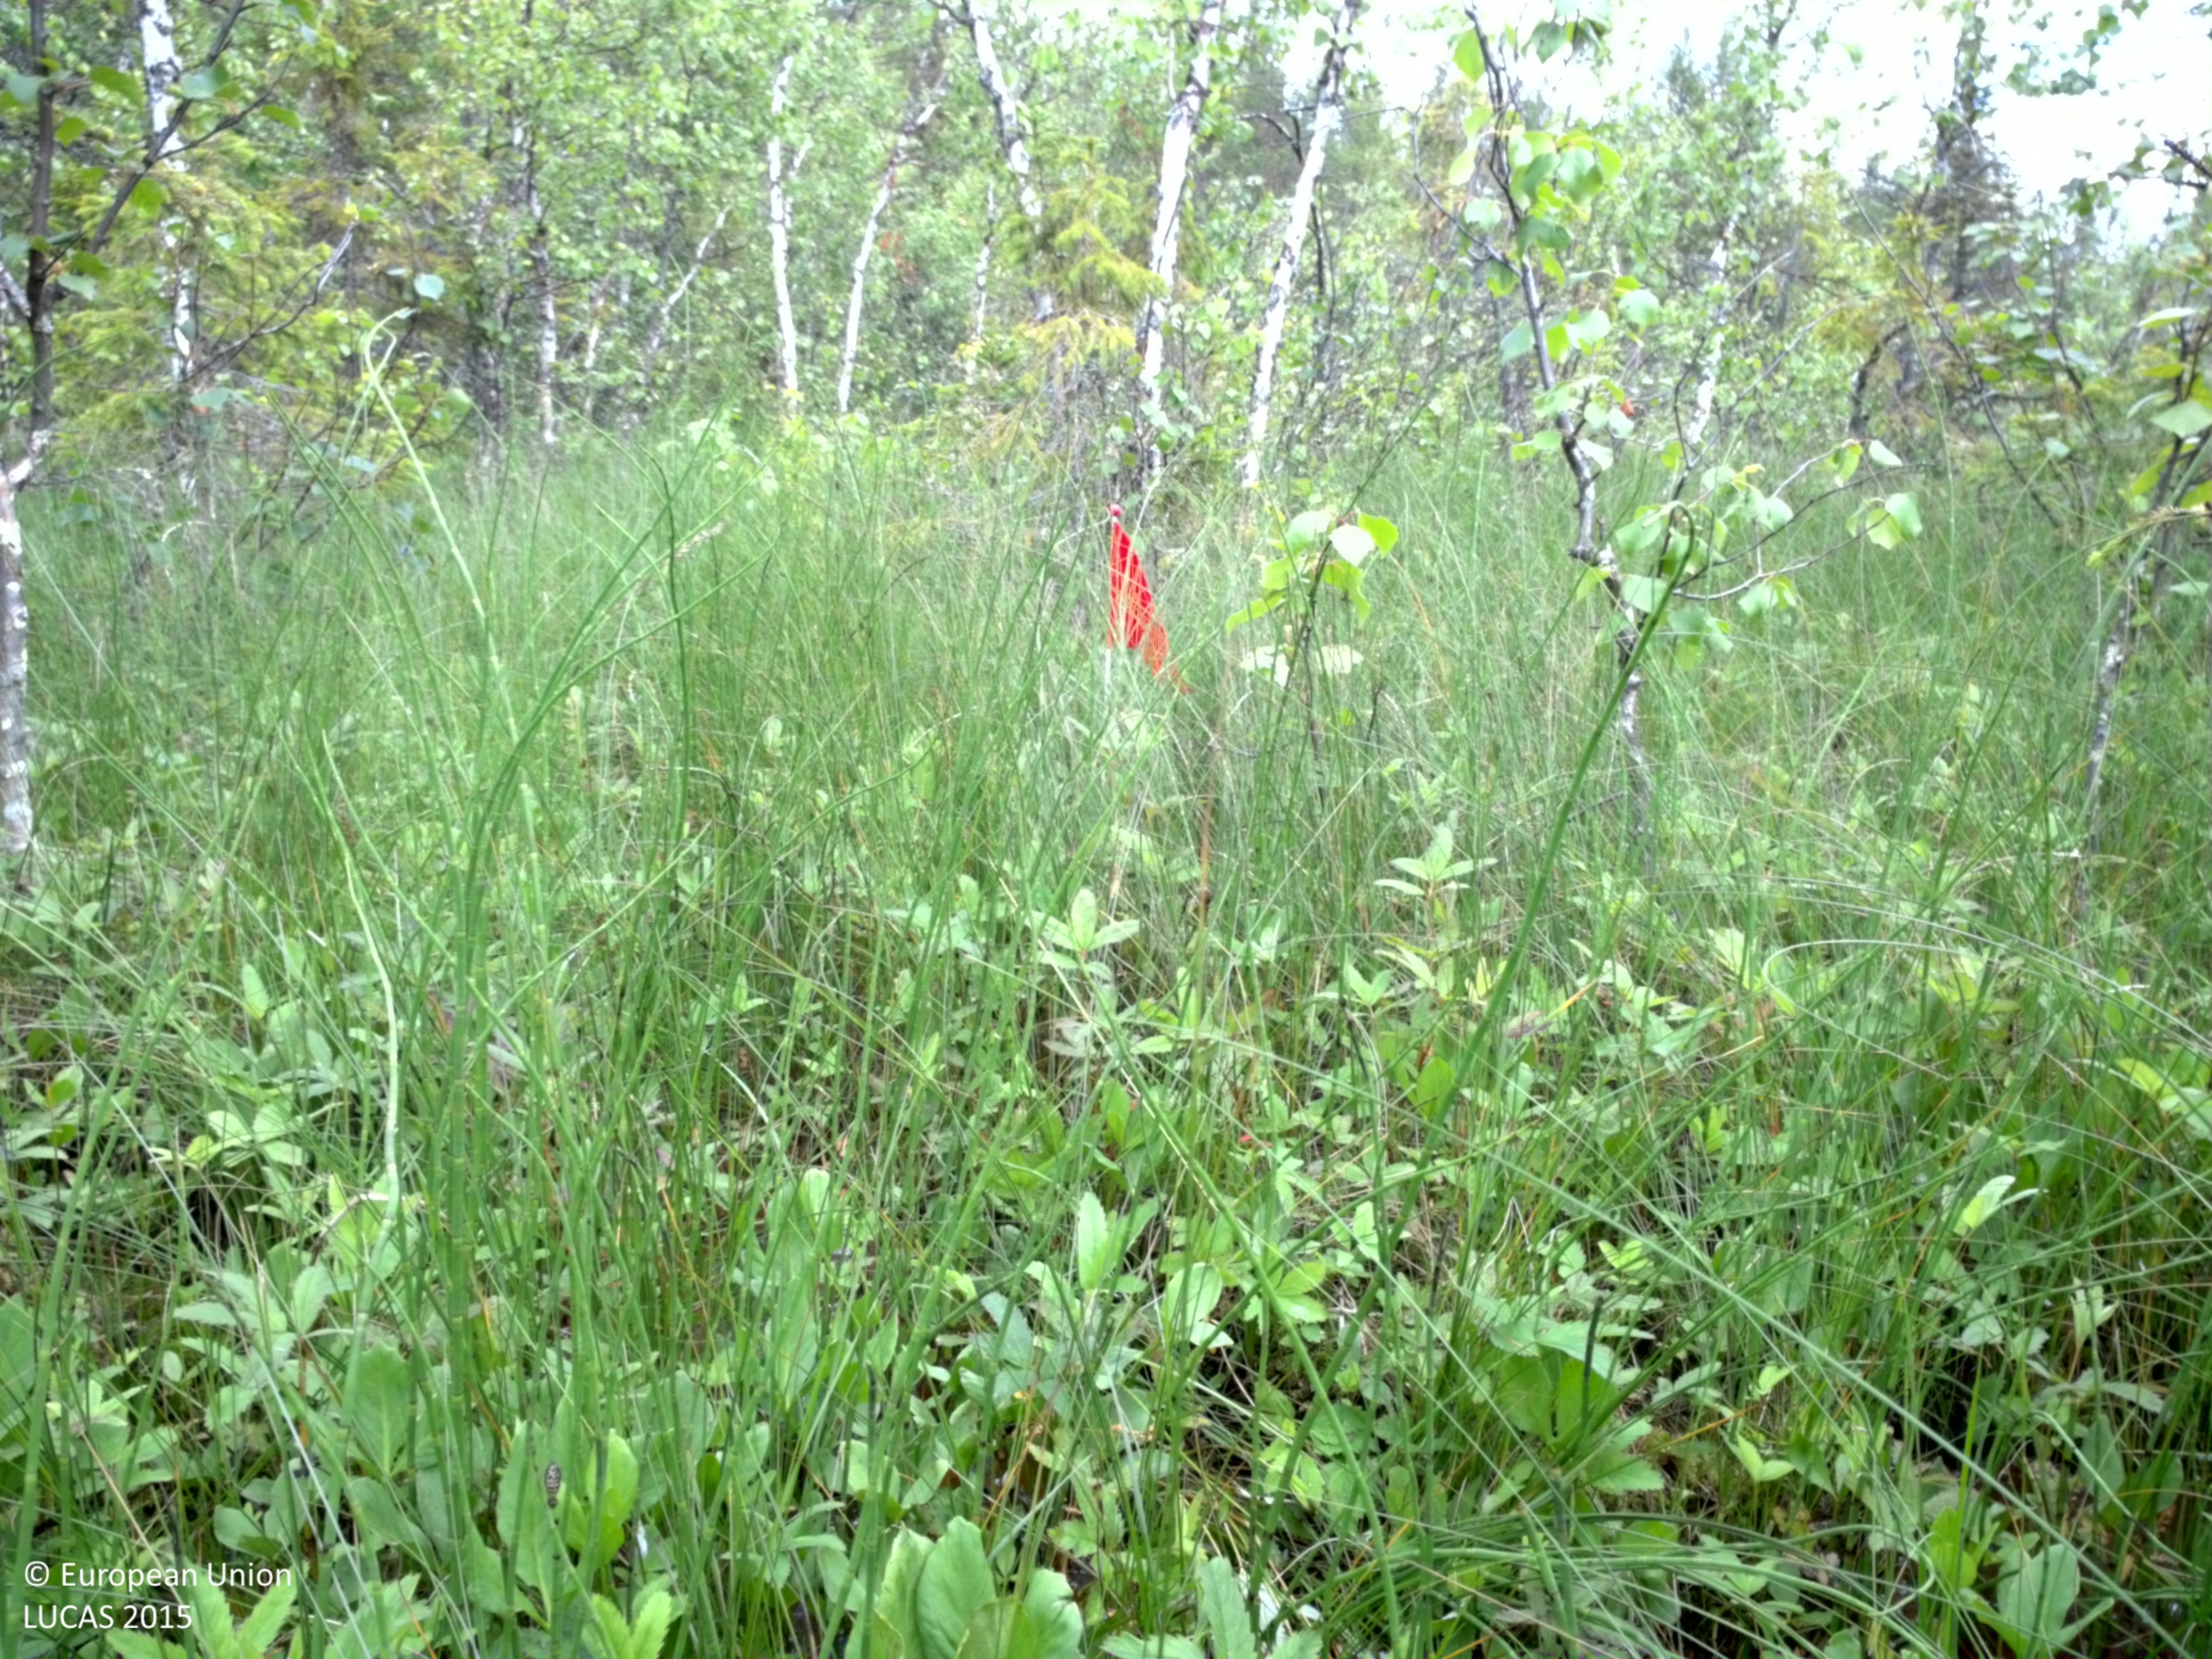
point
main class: Woodland
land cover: Broadleaved woodland
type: mire and swamp forests
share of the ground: 25 - 50 %
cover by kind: herbaceous plants 45 %, broadleaved forest trees 30 %, shrubs 10 %, coniferous forest trees 5 %
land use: Semi-natural and natural areas not in use
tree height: < 5 m
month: August
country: SE
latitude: 66.5139
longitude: 20.8187
